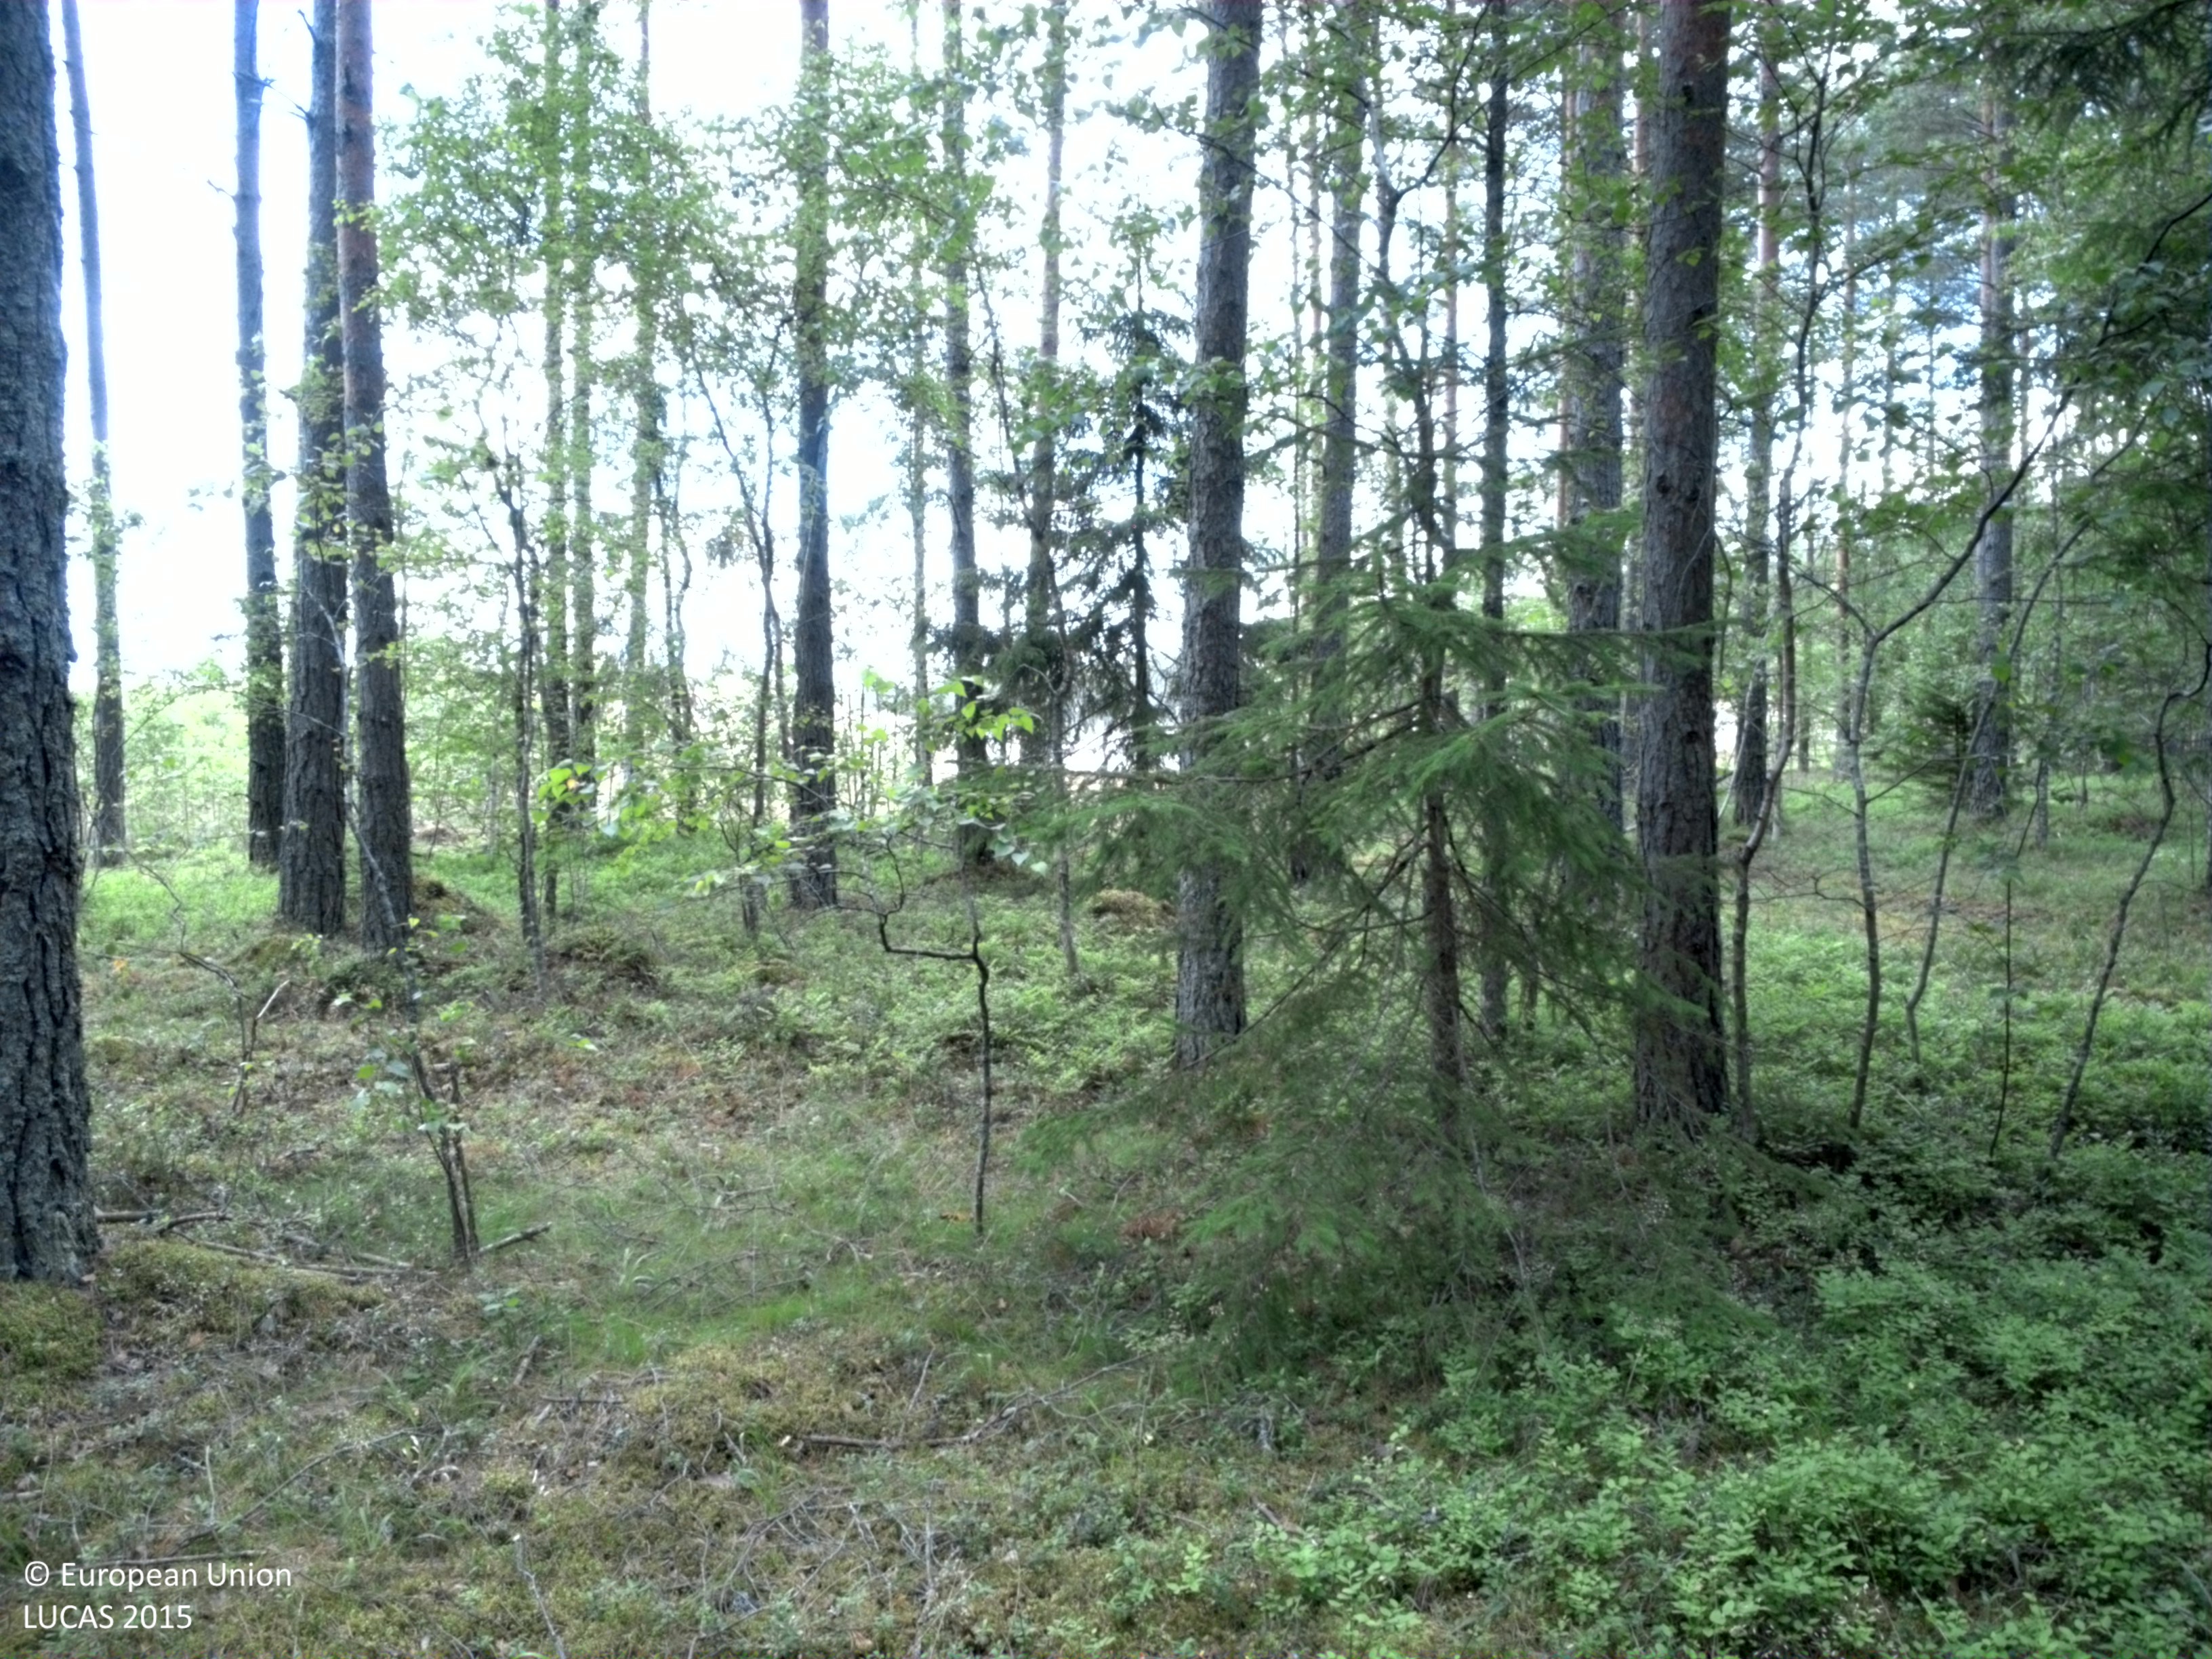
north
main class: Woodland
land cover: Pine dominated mixed woodland
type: boreal forest
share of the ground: > 75 %
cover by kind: coniferous forest trees 60 %, broadleaved forest trees 20 %, herbaceous plants 20 %
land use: Forestry
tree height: > 5 m
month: July
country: SE
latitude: 59.6165
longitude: 18.4900
